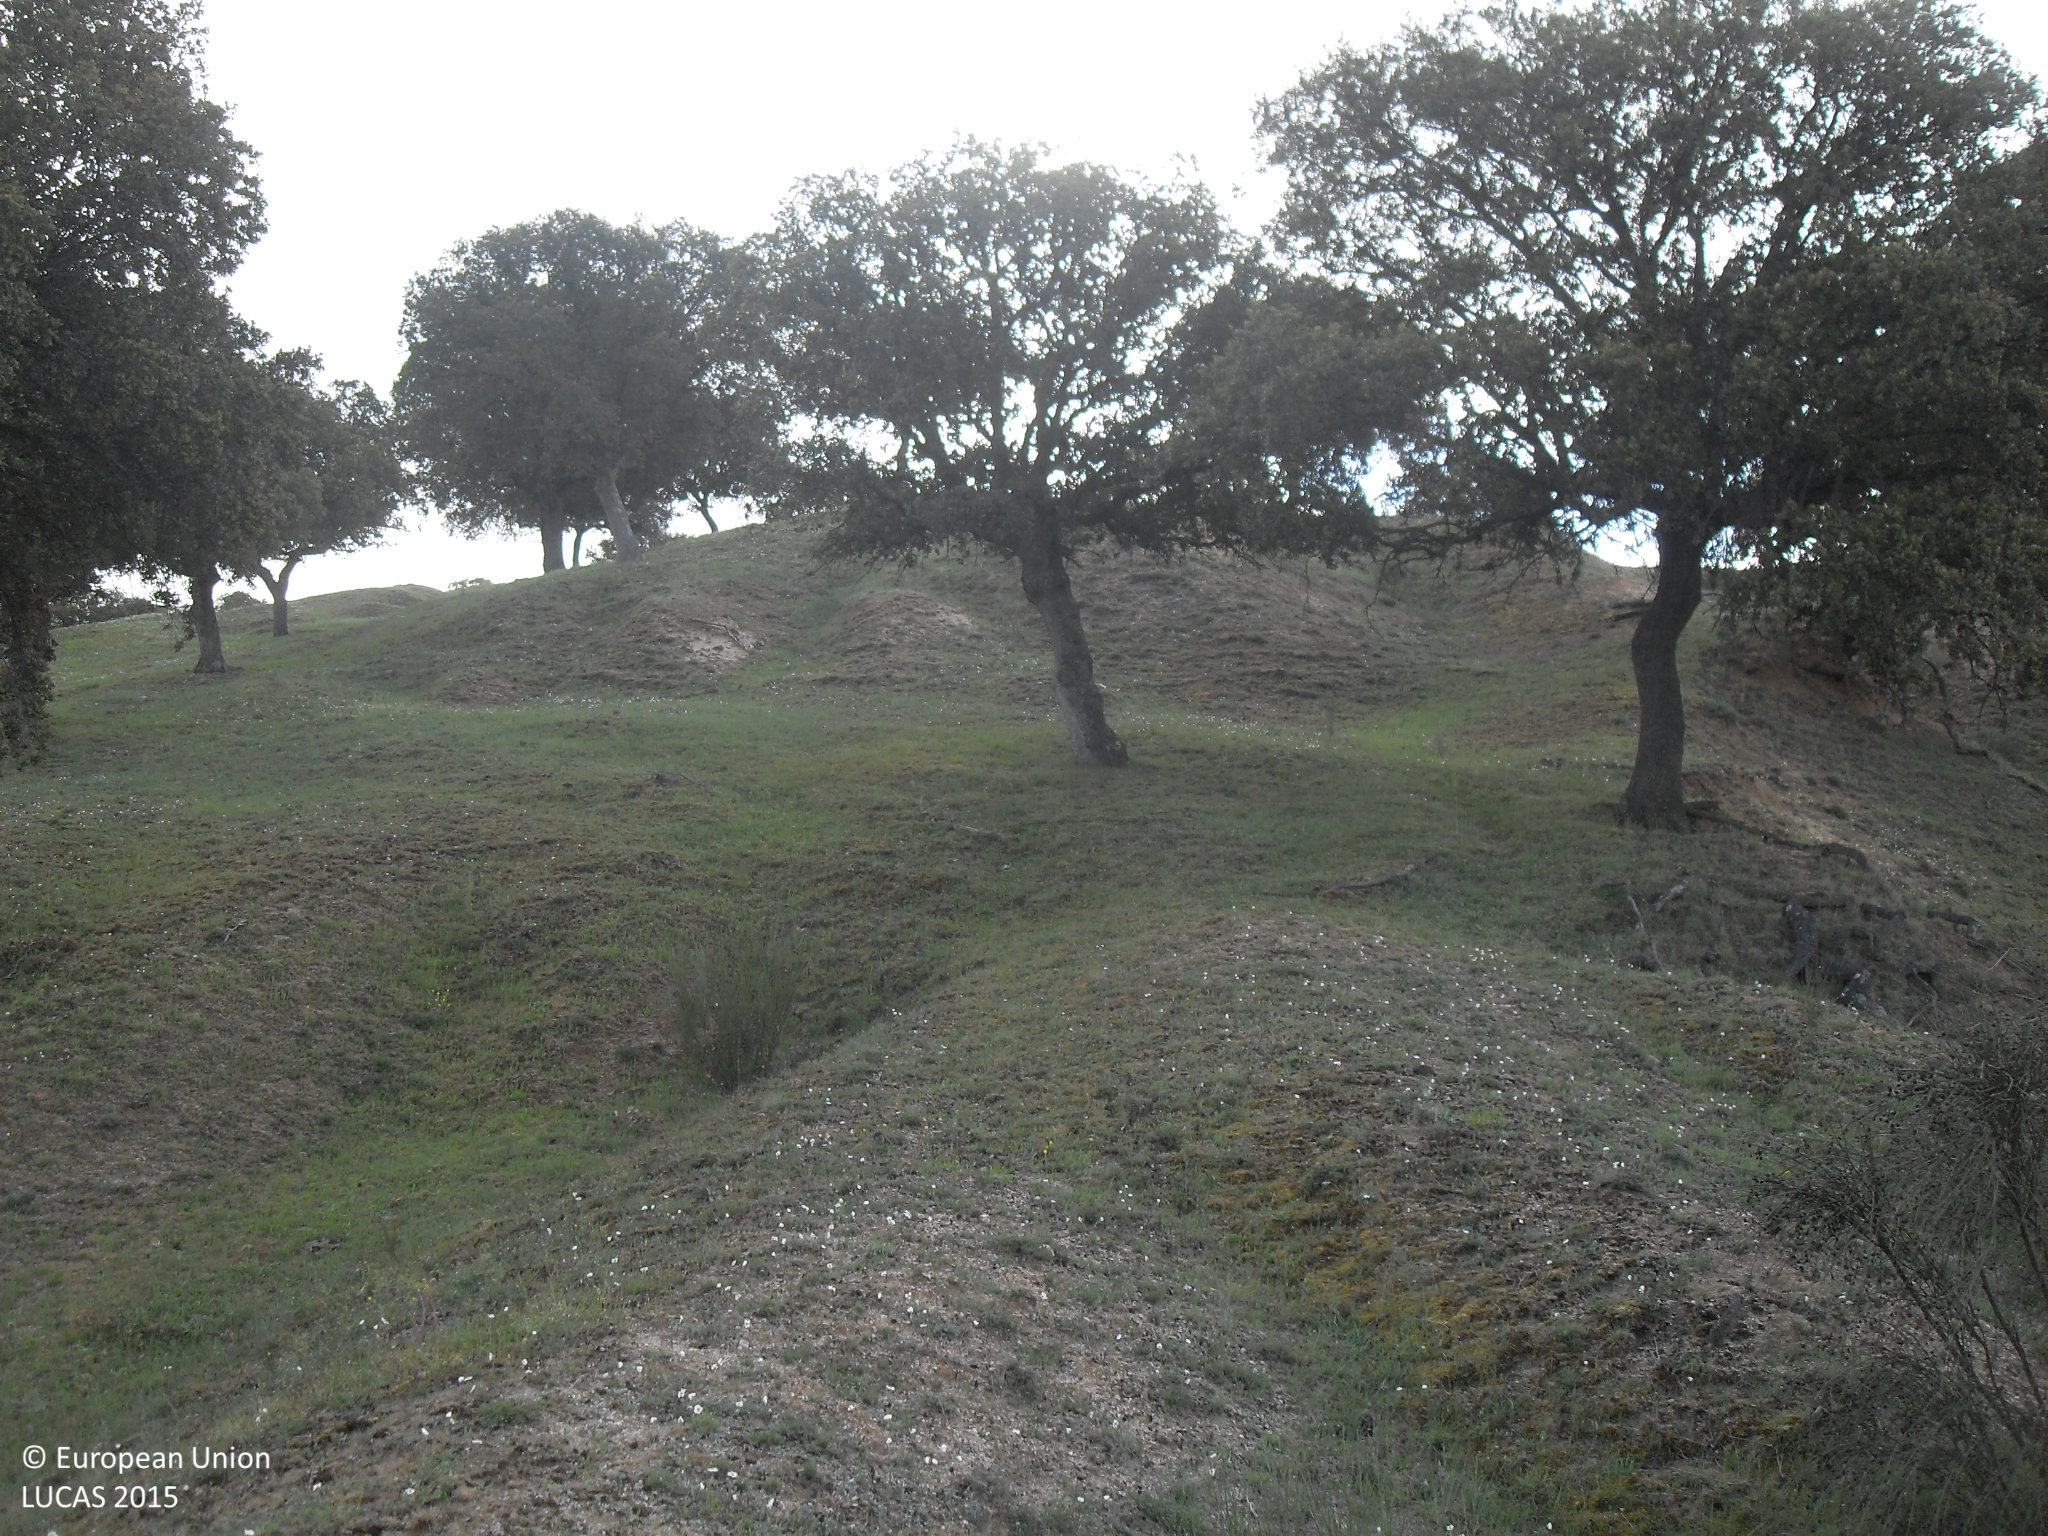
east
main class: Woodland
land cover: Broadleaved woodland
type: broadleaved evergreen forest
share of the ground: 10 - 25 %
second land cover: Grassland without tree/shrub cover
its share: > 75 %
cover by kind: herbaceous plants 85 %, broadleaved forest trees 15 %
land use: Forestry
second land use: Agriculture (excluding fallow land and kitchen gardens)
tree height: > 5 m
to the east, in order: Broadleaved woodland; Grassland without tree/shrub cover; Fences; Rye
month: May
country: ES
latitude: 40.8475
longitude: -5.1413
